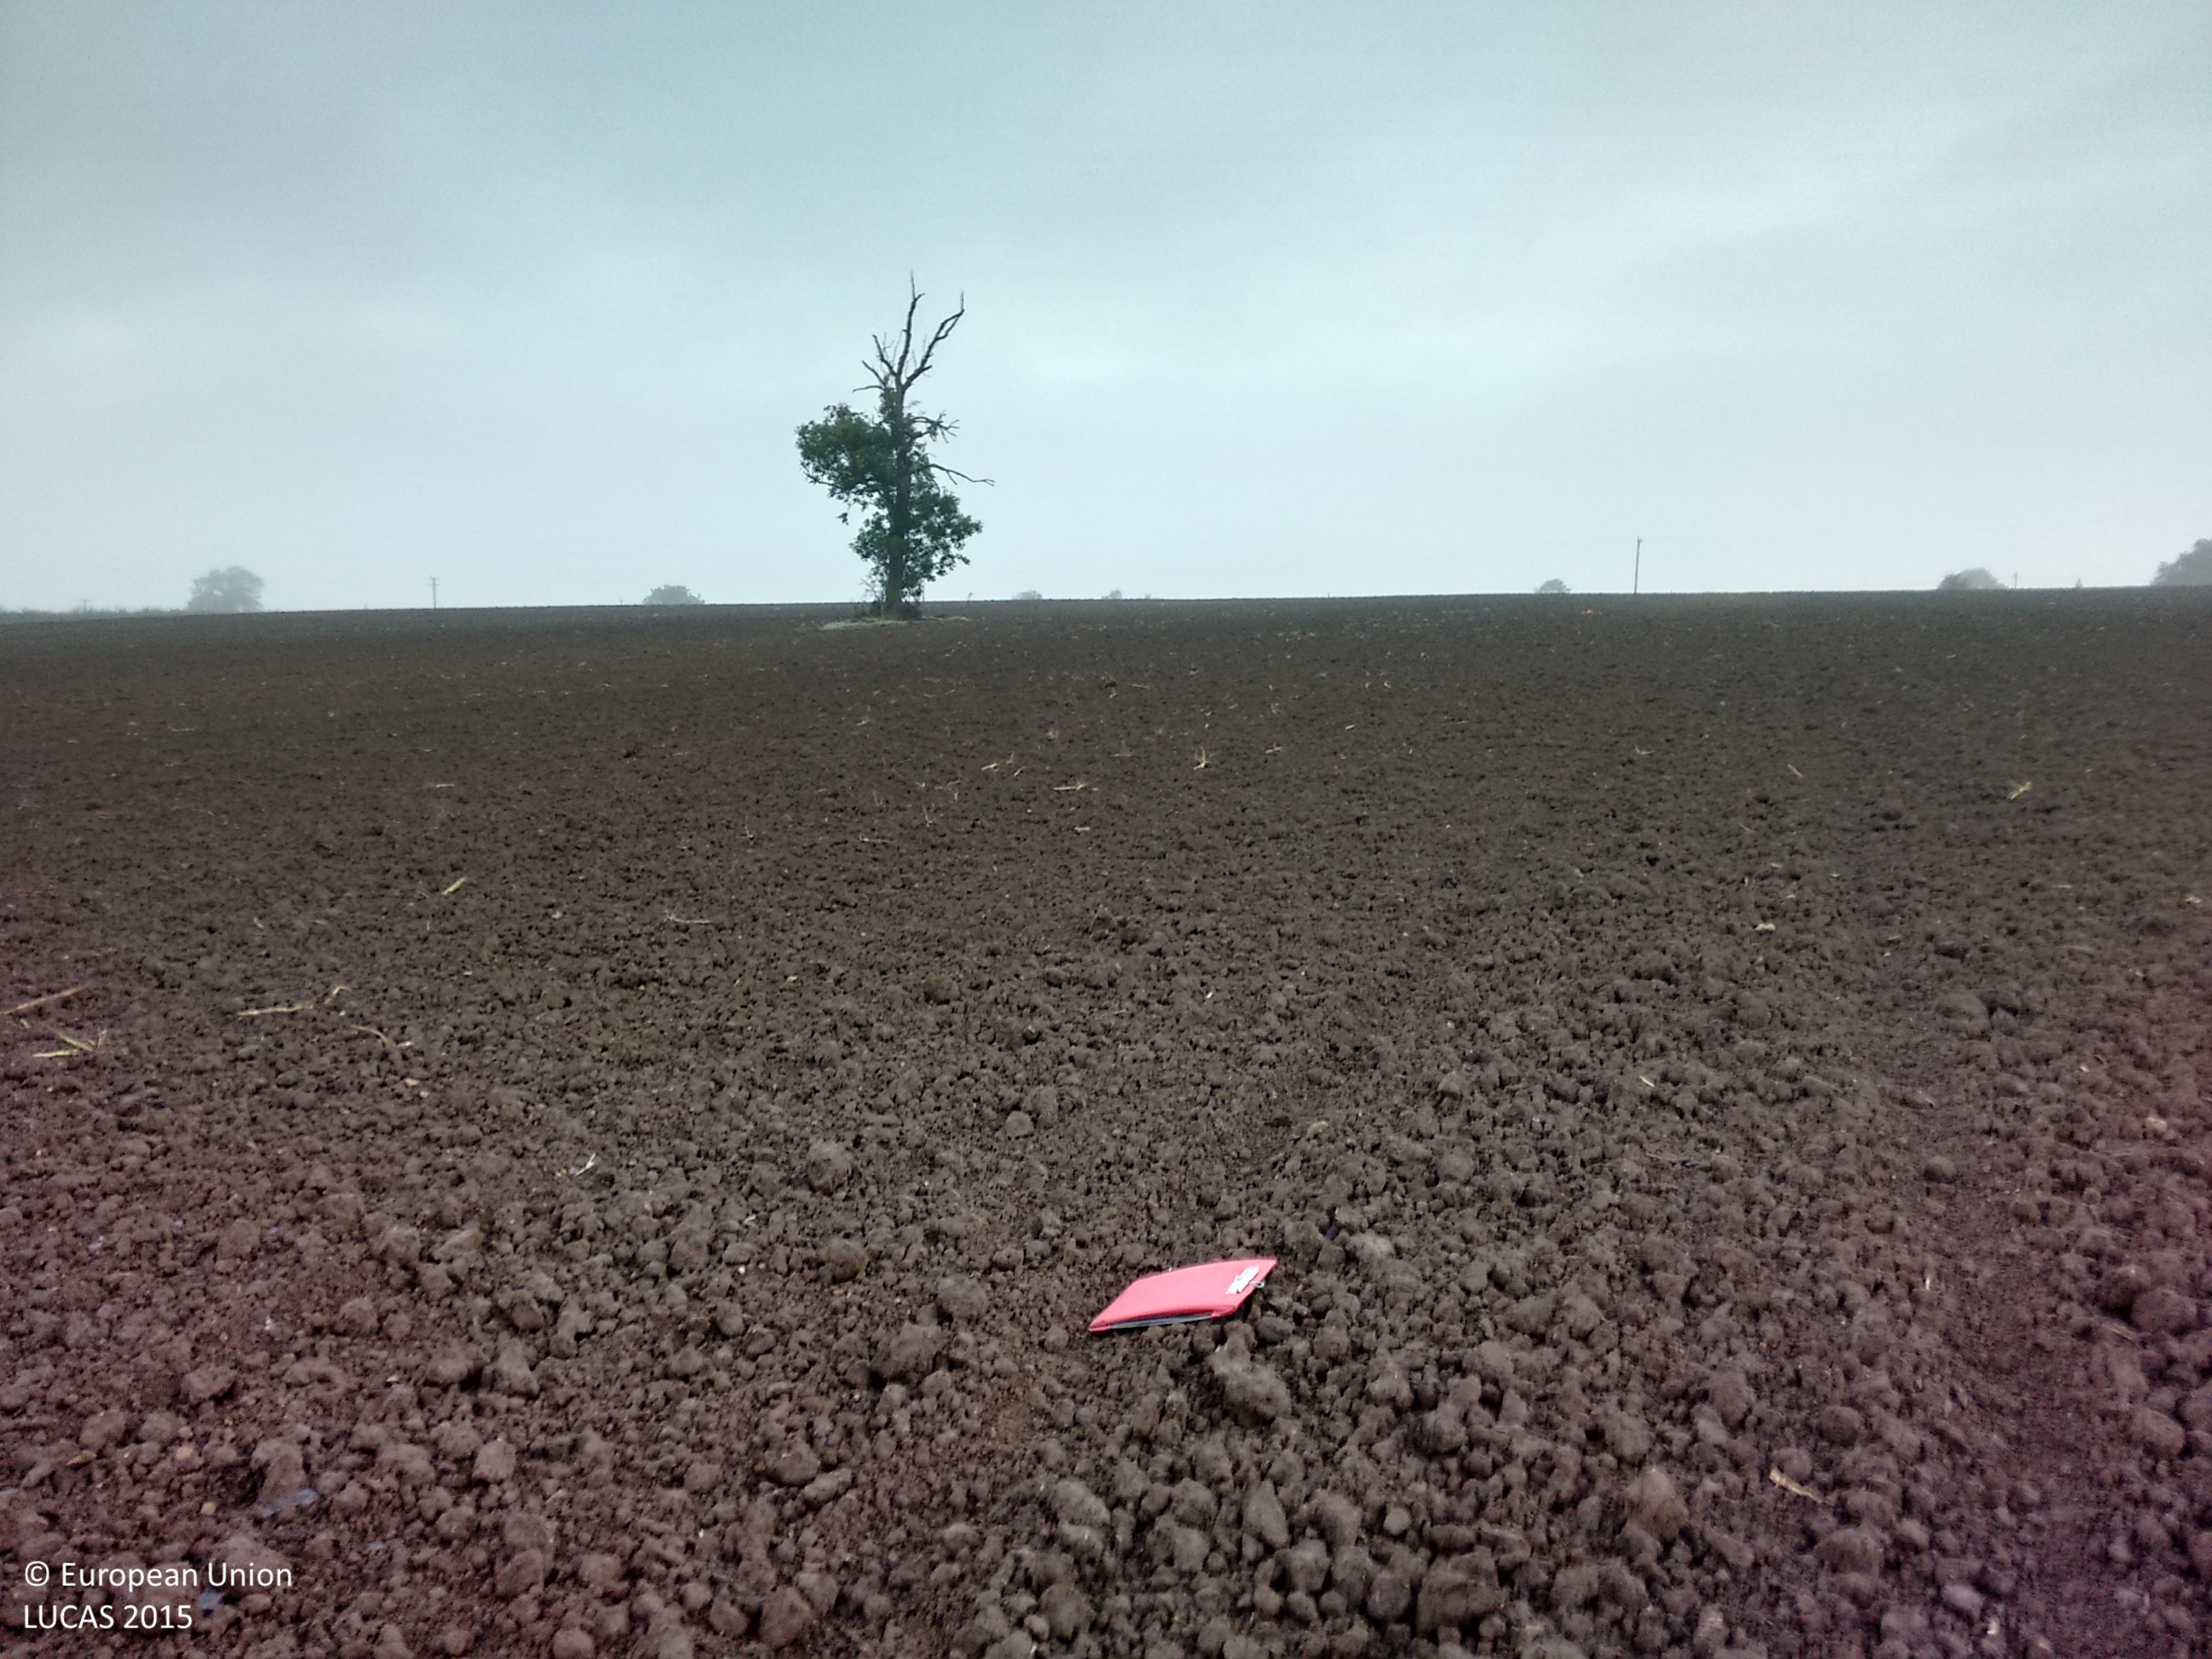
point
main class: Cropland
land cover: Common wheat
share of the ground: > 75 %
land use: Agriculture (excluding fallow land and kitchen gardens)
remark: Harvested field
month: October
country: GB
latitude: 51.7289
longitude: -2.3562
